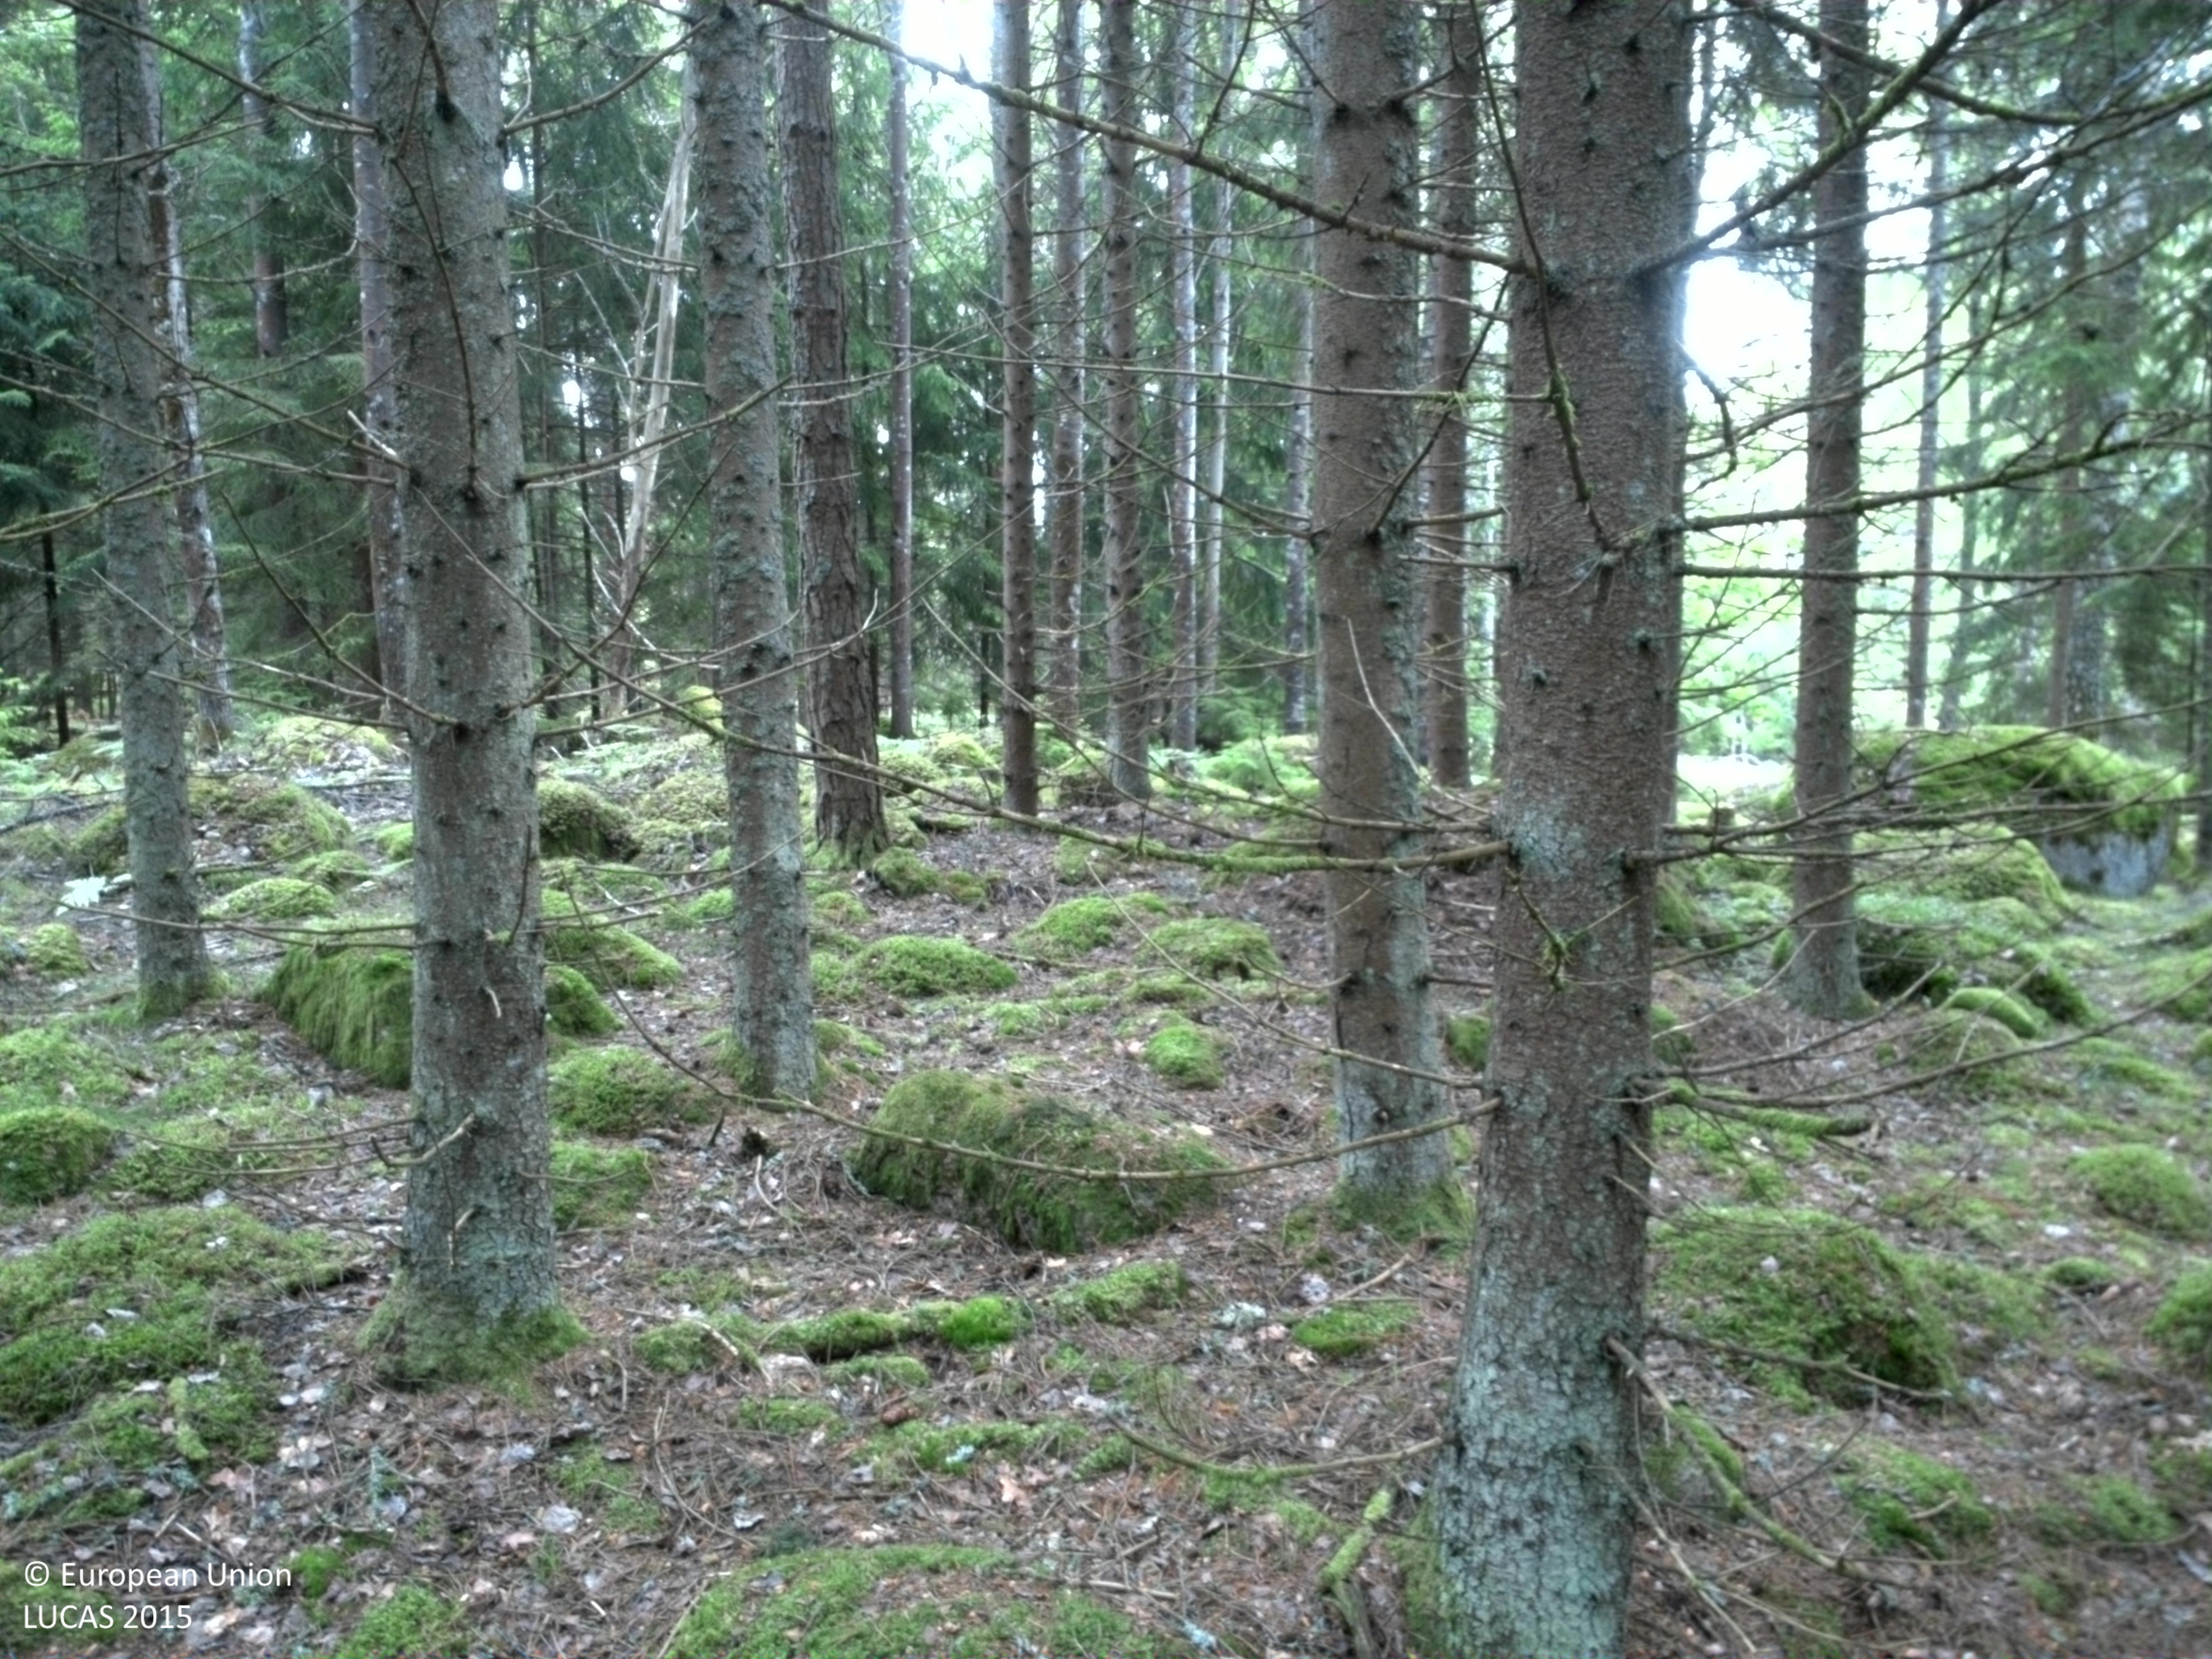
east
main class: Woodland
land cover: Spruce dominated coniferous woodland
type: boreal forest
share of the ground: 50 - 75 %
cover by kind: coniferous forest trees 70 %, lichens and mosses 30 %
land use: Forestry
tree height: > 5 m
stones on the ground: 10 - 25 %
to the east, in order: Spruce dominated coniferous woodland; Spruce dominated mixed woodland; Electric lines; Spruce dominated coniferous woodland; Tracks; Spruce dominated coniferous woodland; Rivers and streams; Spruce dominated mixed woodland; Broadleaved woodland; Electric lines; Paved roads, cycling and walking lanes; Ditches and canals; Grassland without tree/shrub cover
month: June
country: SE
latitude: 58.5367
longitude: 15.5767
